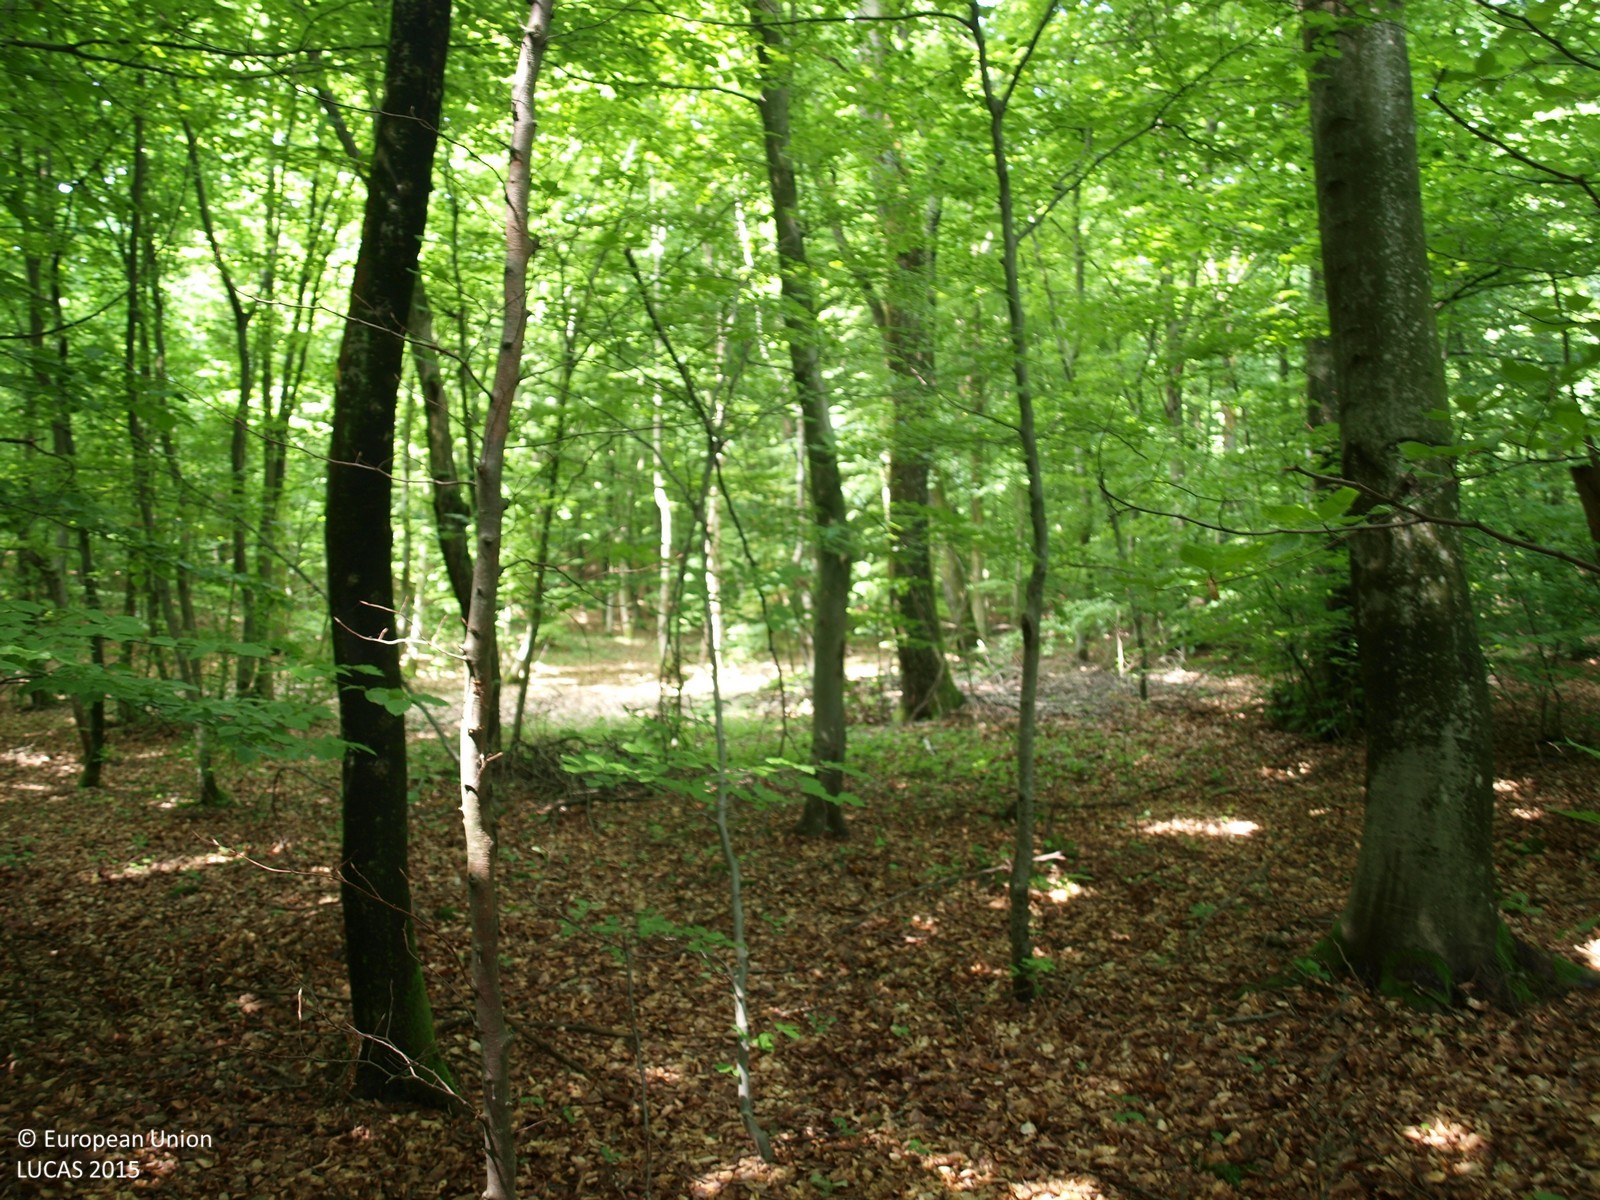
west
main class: Woodland
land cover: Broadleaved woodland
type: mesophytic deciduous forest
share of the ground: > 75 %
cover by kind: broadleaved forest trees 95 %, shrubs 5 %
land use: Forestry
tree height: > 5 m
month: May
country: HR
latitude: 46.0799
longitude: 16.2190
